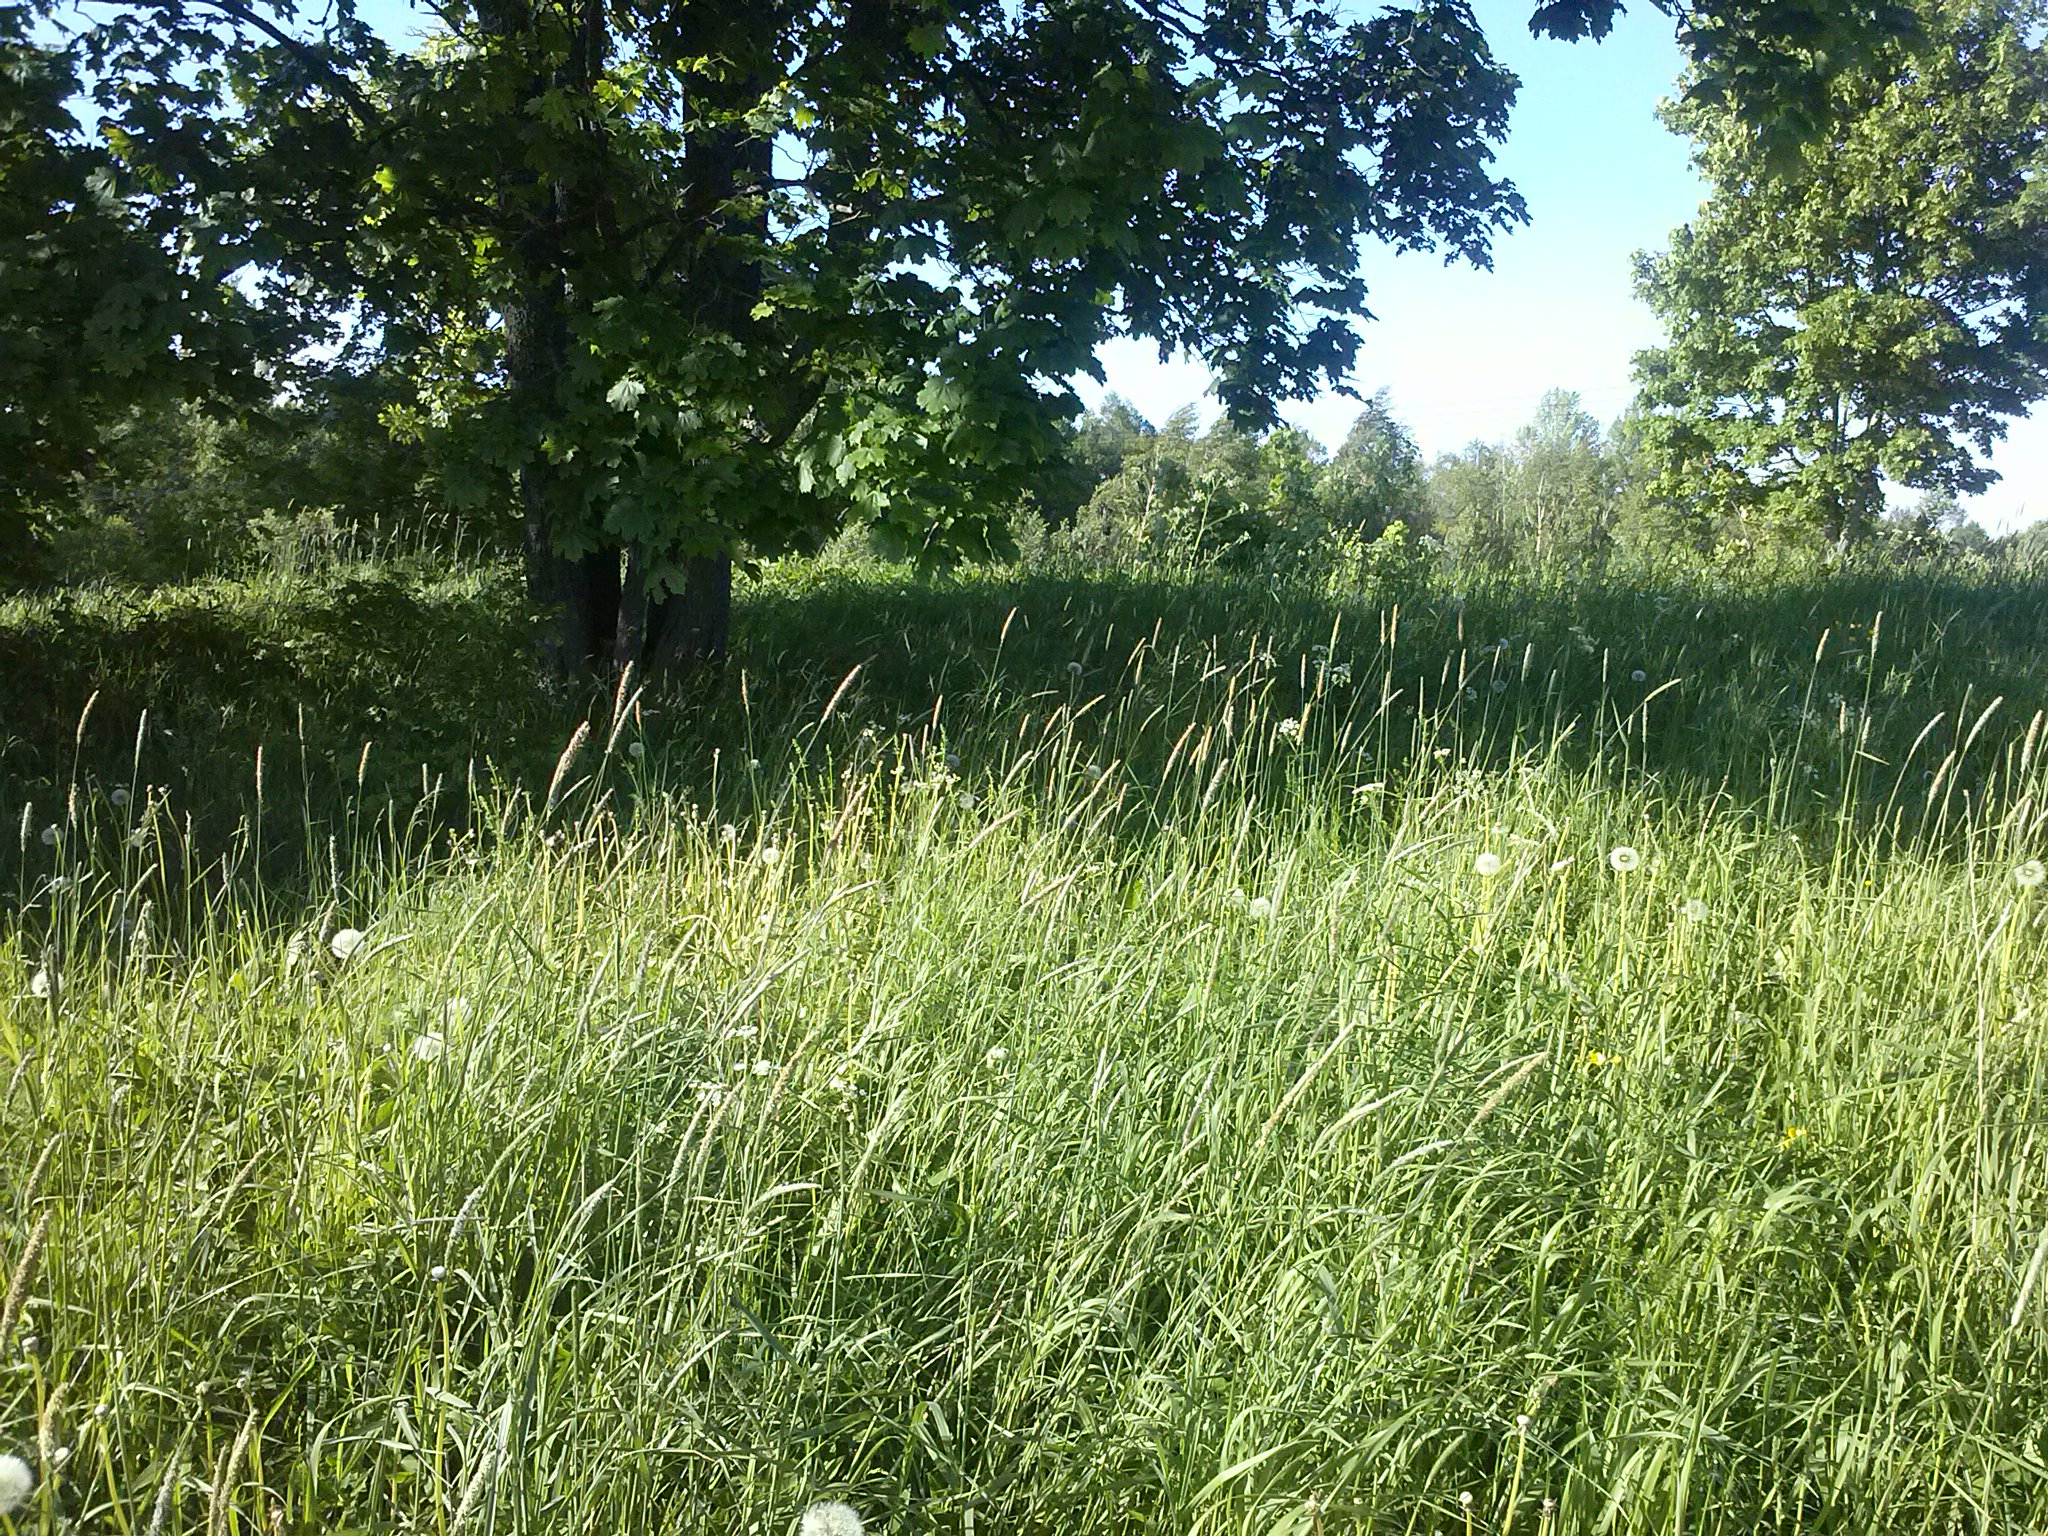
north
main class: Grassland
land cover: Grassland without tree/shrub cover
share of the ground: > 75 %
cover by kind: herbaceous plants 100 %
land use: Agriculture (excluding fallow land and kitchen gardens)
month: June
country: LV
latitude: 56.3442
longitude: 27.7090
